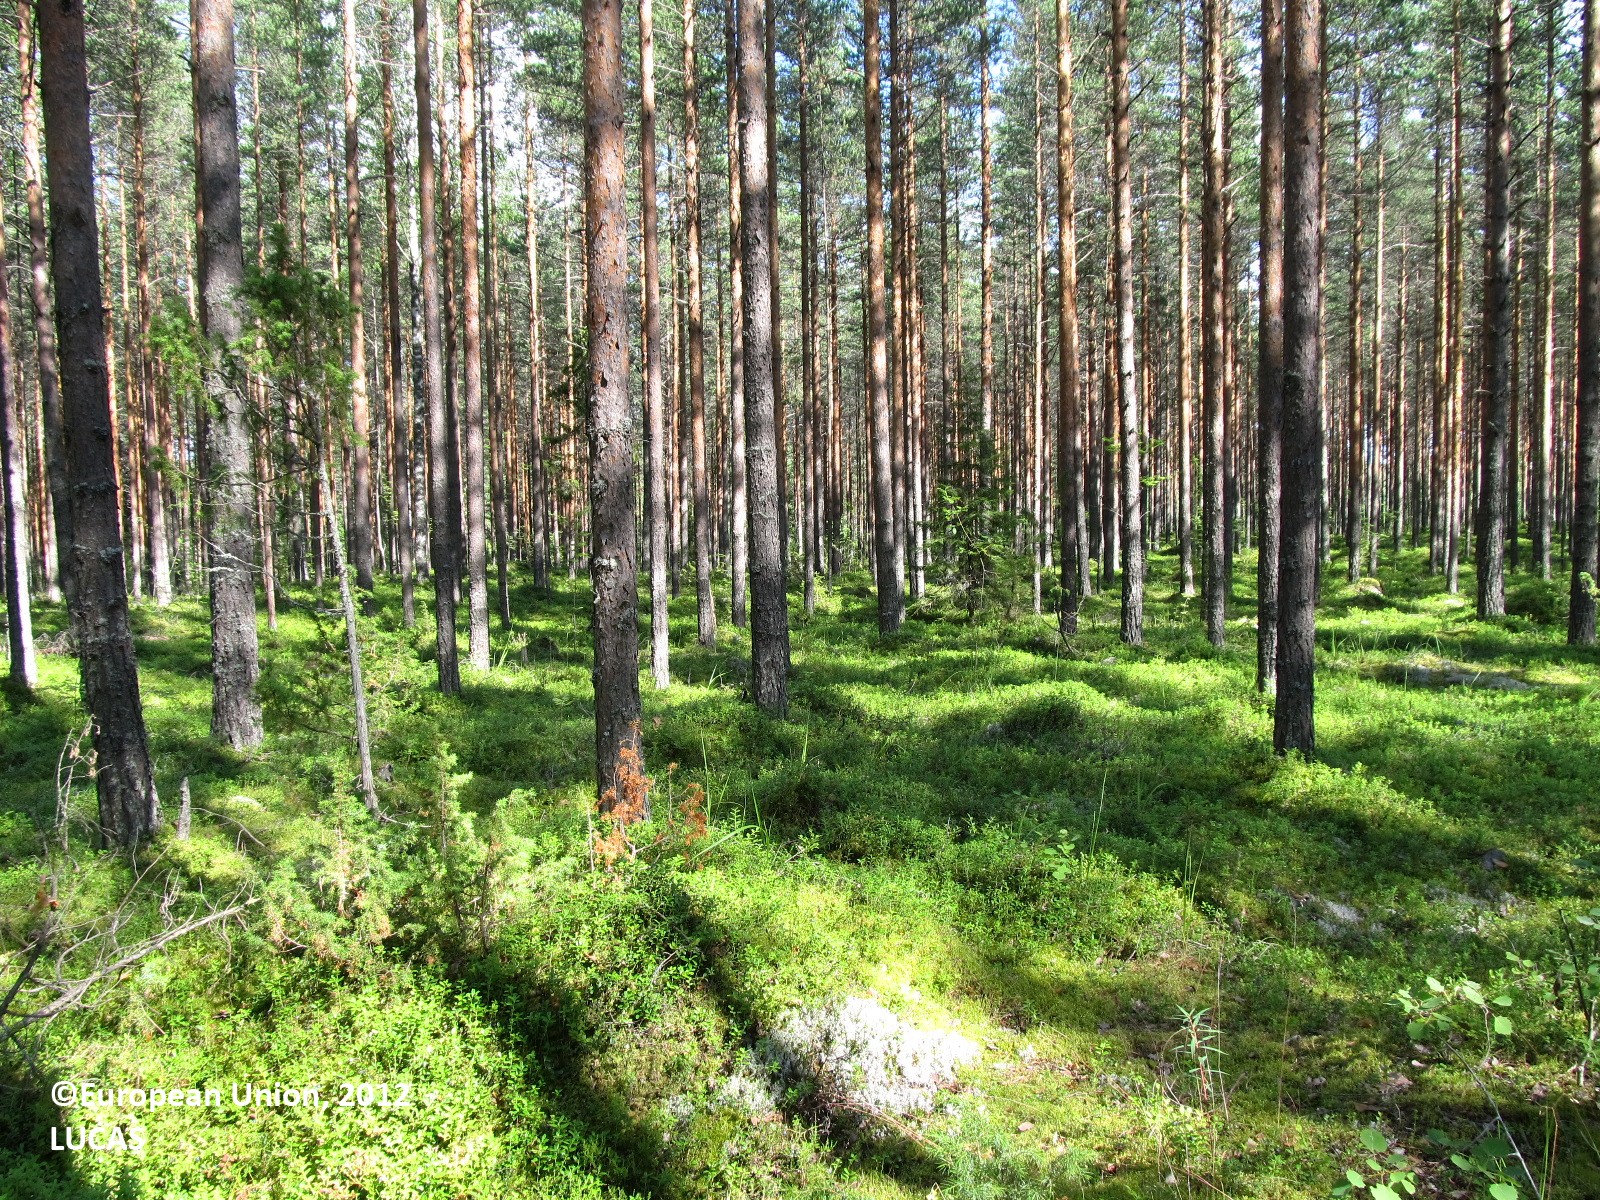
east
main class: Woodland
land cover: Pine dominated coniferous woodland
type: boreal forest
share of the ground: 50 - 75 %
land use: Forestry
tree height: > 5 m
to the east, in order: Pine dominated coniferous woodland; Electric lines; Spruce dominated coniferous woodland
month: July
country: FI
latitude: 61.8698
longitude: 27.9662
